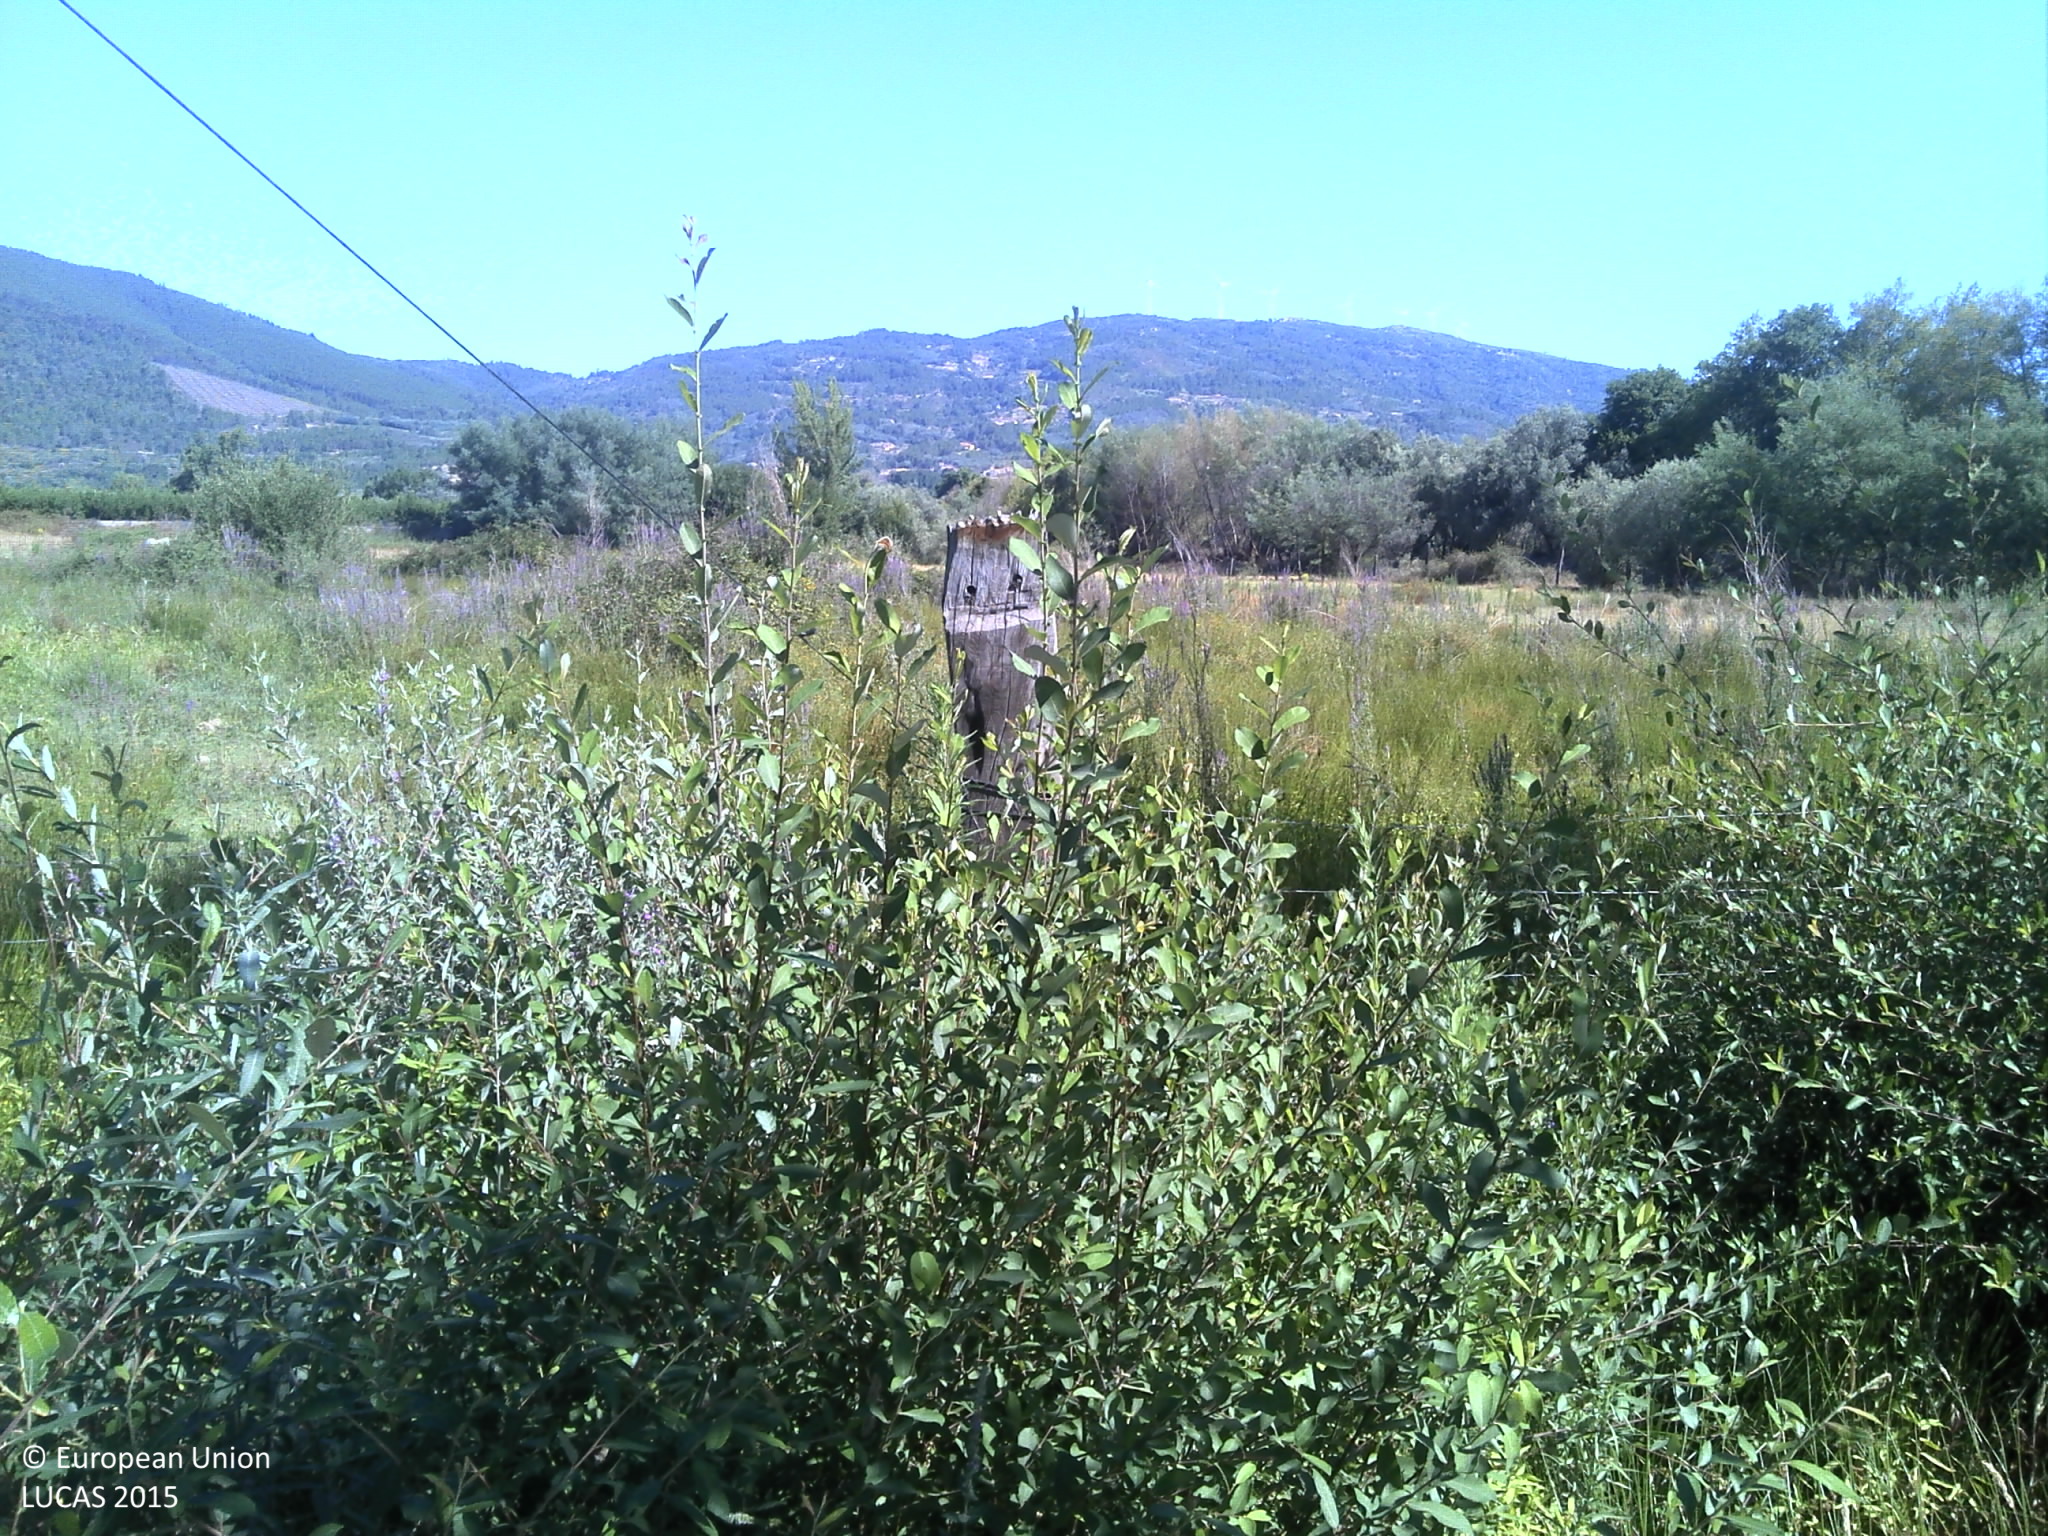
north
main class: Woodland
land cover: Broadleaved woodland
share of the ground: 25 - 50 %
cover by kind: shrubs 45 %, broadleaved forest trees 25 %, herbaceous plants 15 %, unconsolidated bare surface 15 %
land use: Semi-natural and natural areas not in use
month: July
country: PT
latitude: 40.3849
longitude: -7.3628
